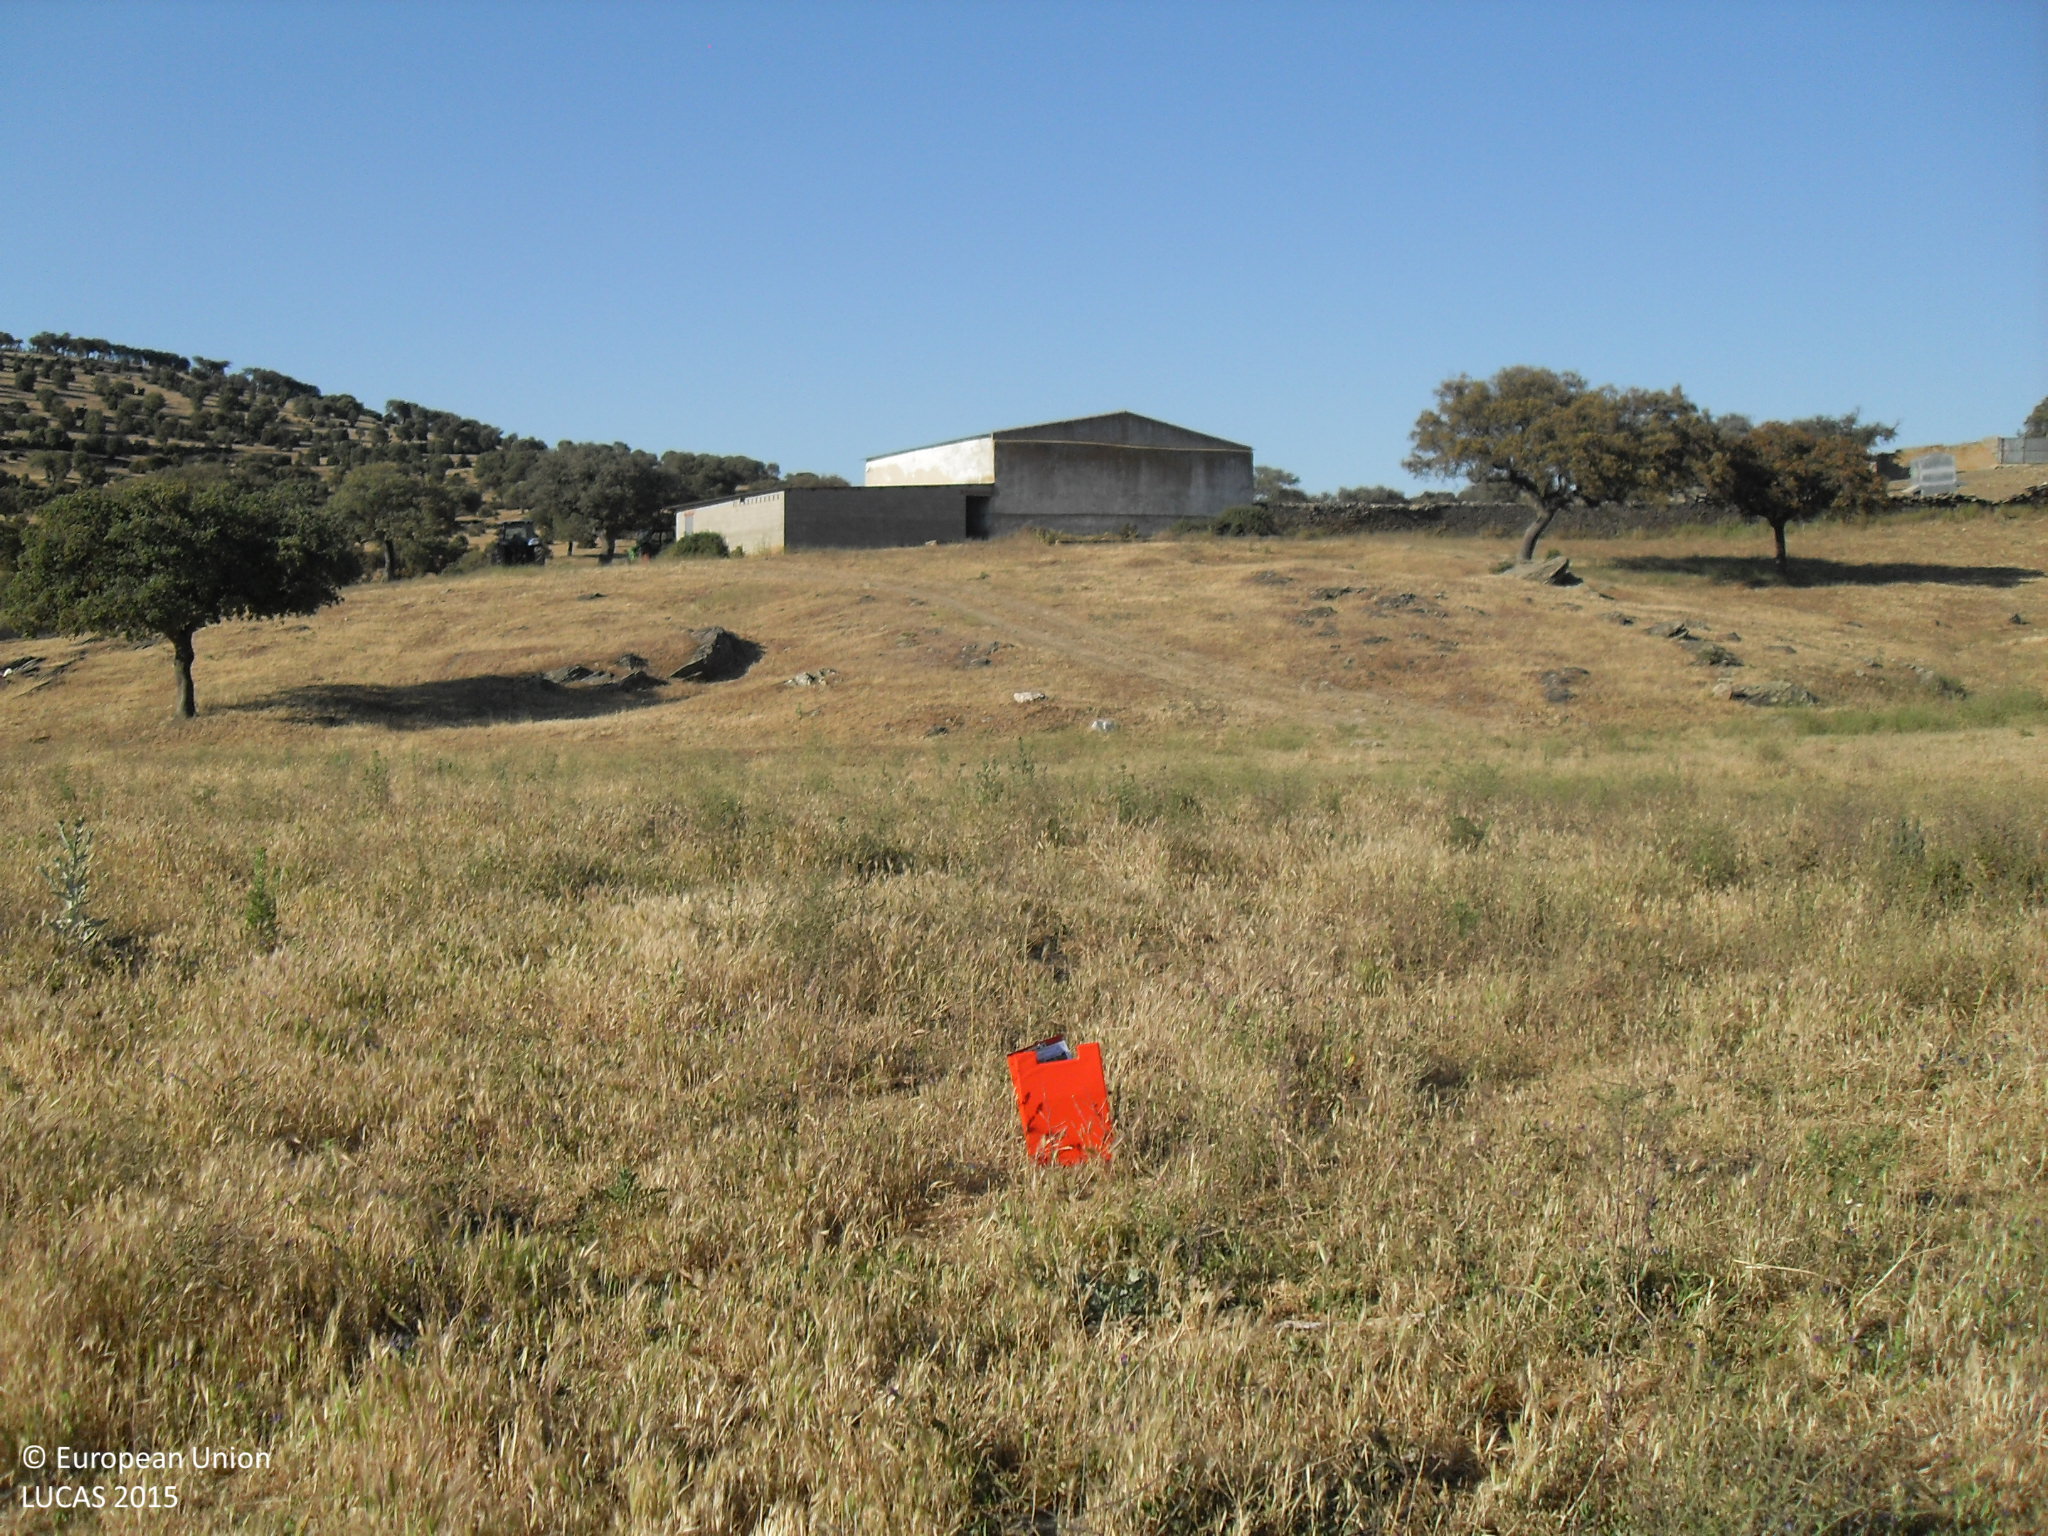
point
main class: Grassland
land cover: Grassland without tree/shrub cover
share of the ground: > 75 %
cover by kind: herbaceous plants 100 %
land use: Agriculture (excluding fallow land and kitchen gardens)
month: June
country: ES
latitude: 40.5801
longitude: -5.5575
